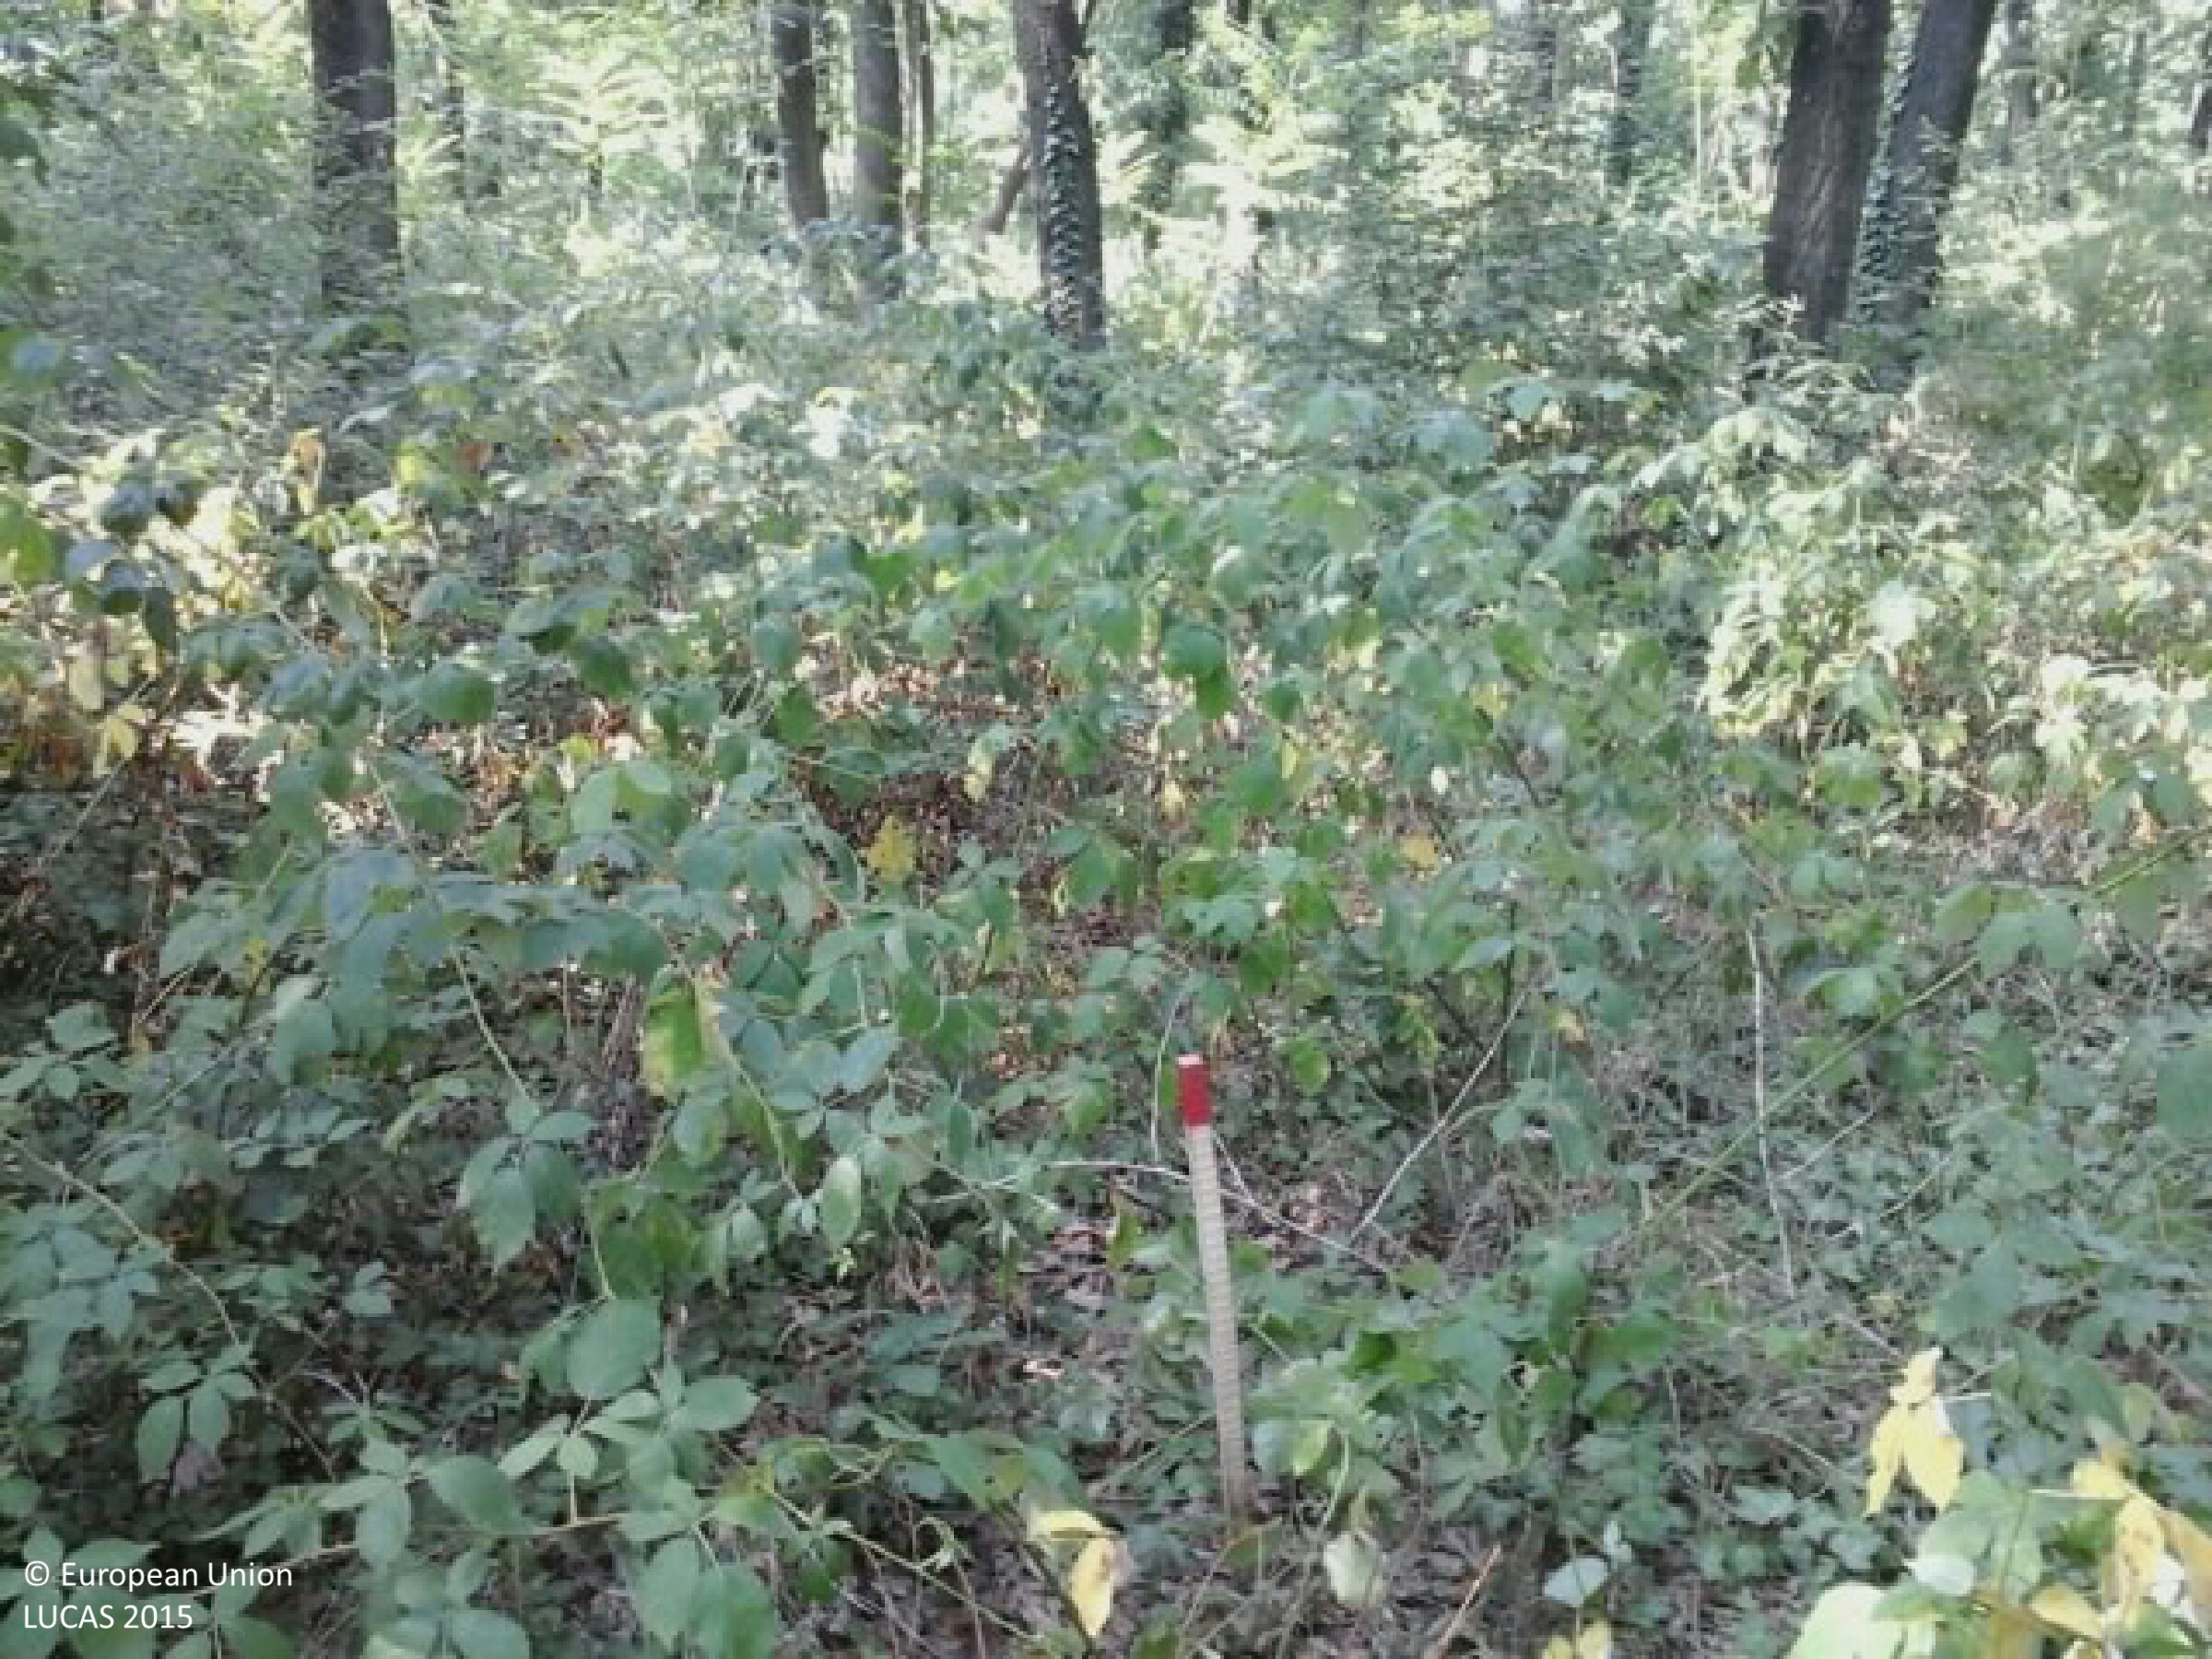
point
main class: Woodland
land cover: Broadleaved woodland
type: mesophytic deciduous forest
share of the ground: > 75 %
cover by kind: broadleaved forest trees 90 %, shrubs 5 %, herbaceous plants 5 %
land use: Forestry
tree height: > 5 m
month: August
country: HU
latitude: 46.5596
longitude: 17.9777
